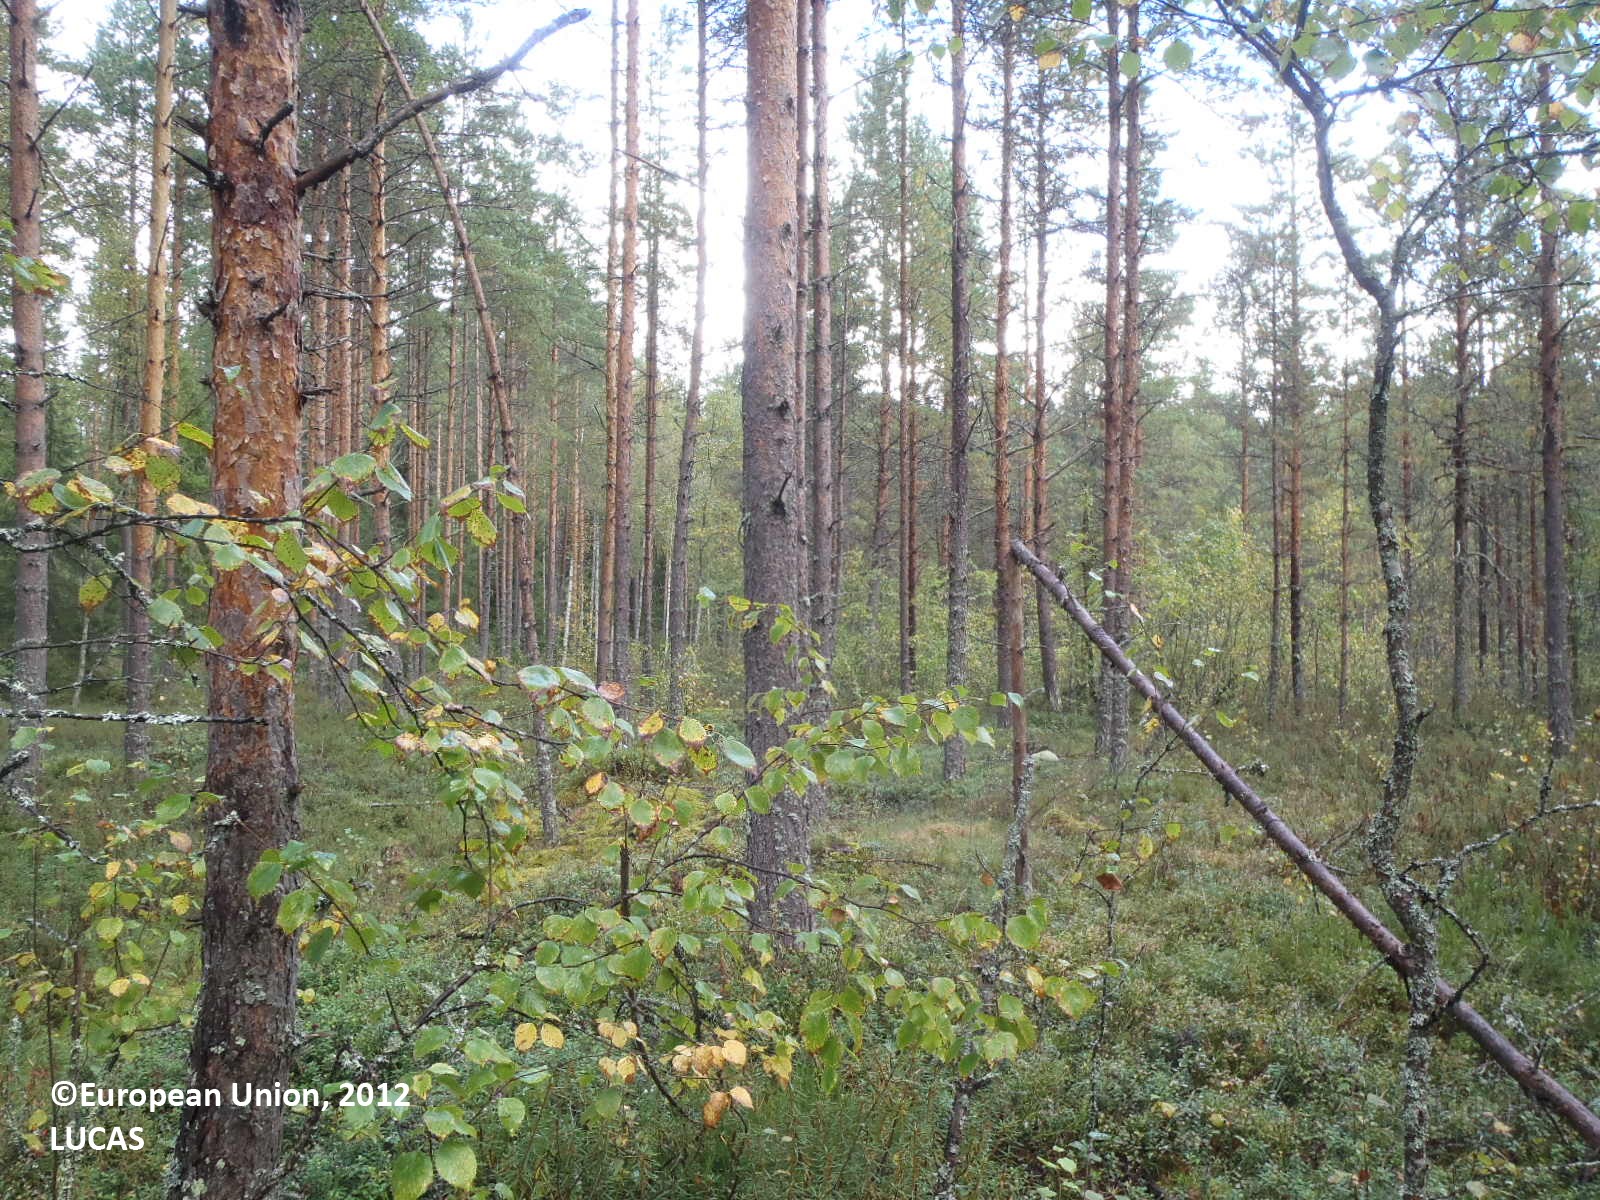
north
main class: Woodland
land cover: Pine dominated coniferous woodland
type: boreal forest
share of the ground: > 75 %
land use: Forestry
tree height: > 5 m
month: September
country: FI
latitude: 61.7157
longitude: 22.7979
